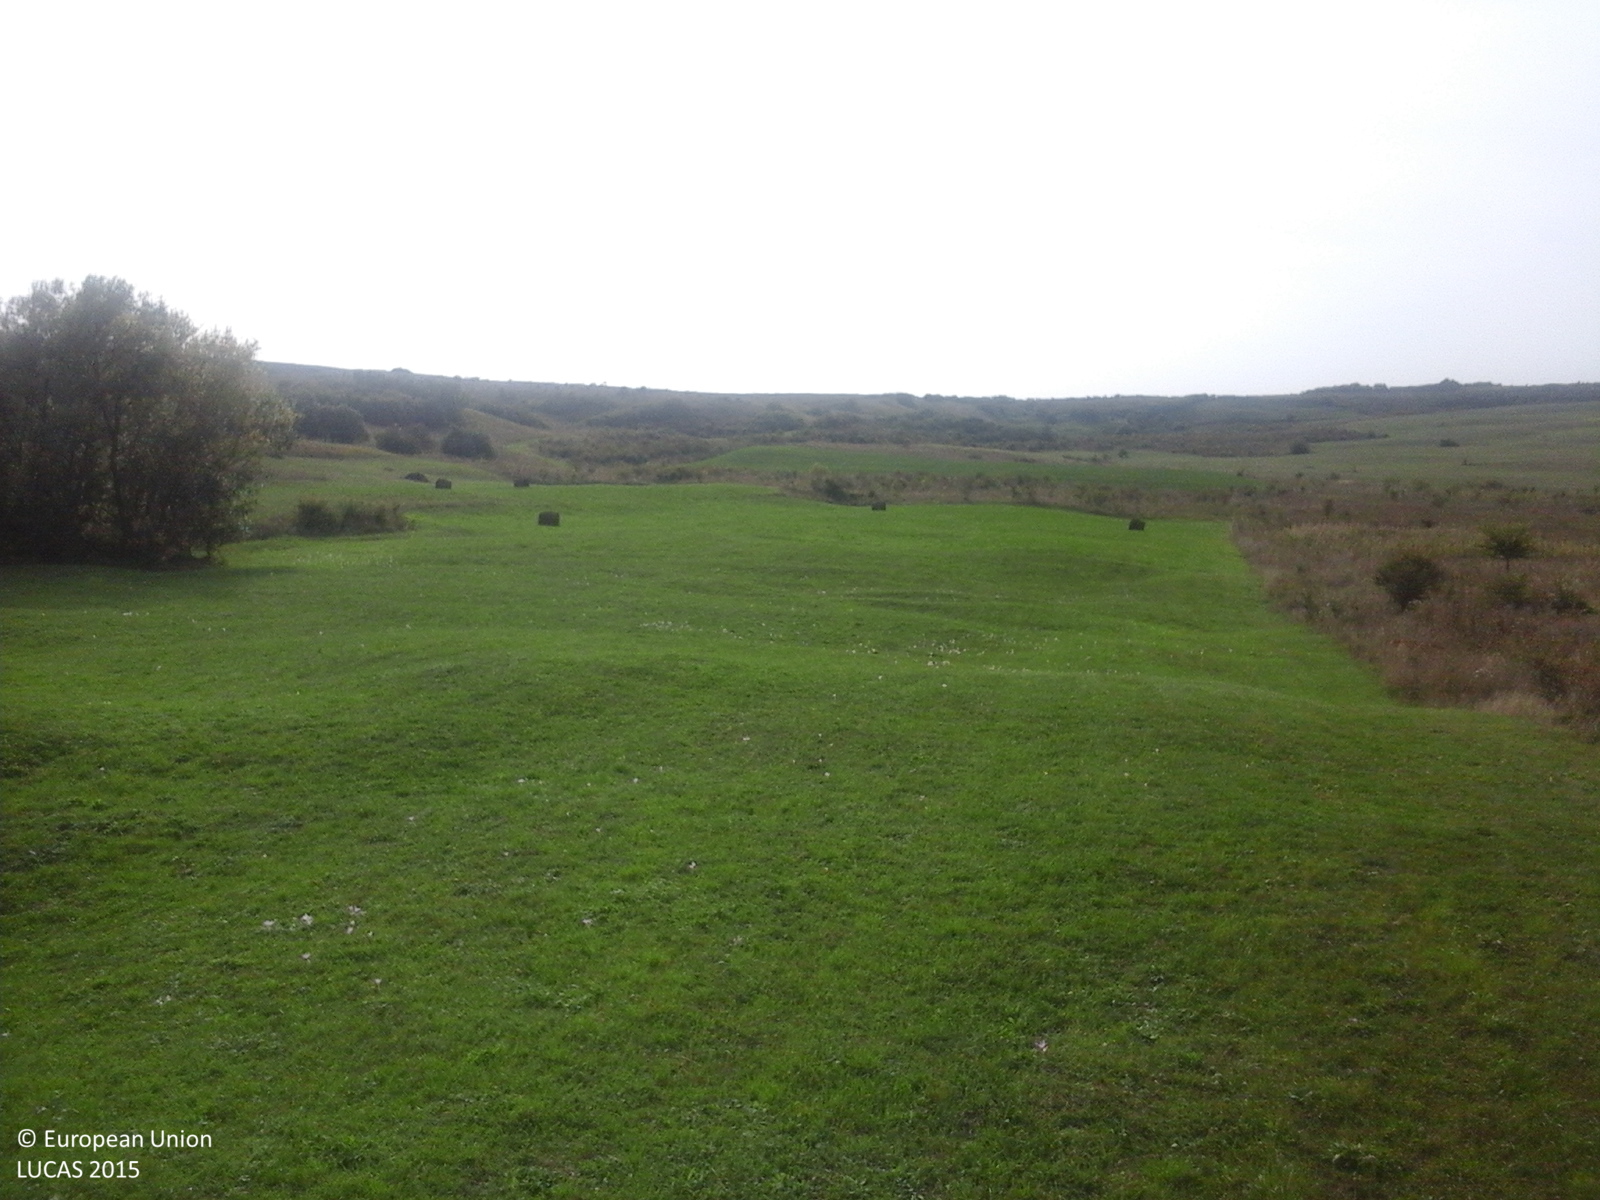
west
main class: Grassland
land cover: Grassland without tree/shrub cover
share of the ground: > 75 %
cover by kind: herbaceous plants 100 %
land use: Agriculture (excluding fallow land and kitchen gardens)
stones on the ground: < 10 %
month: September
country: RO
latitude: 46.9150
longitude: 23.6364
